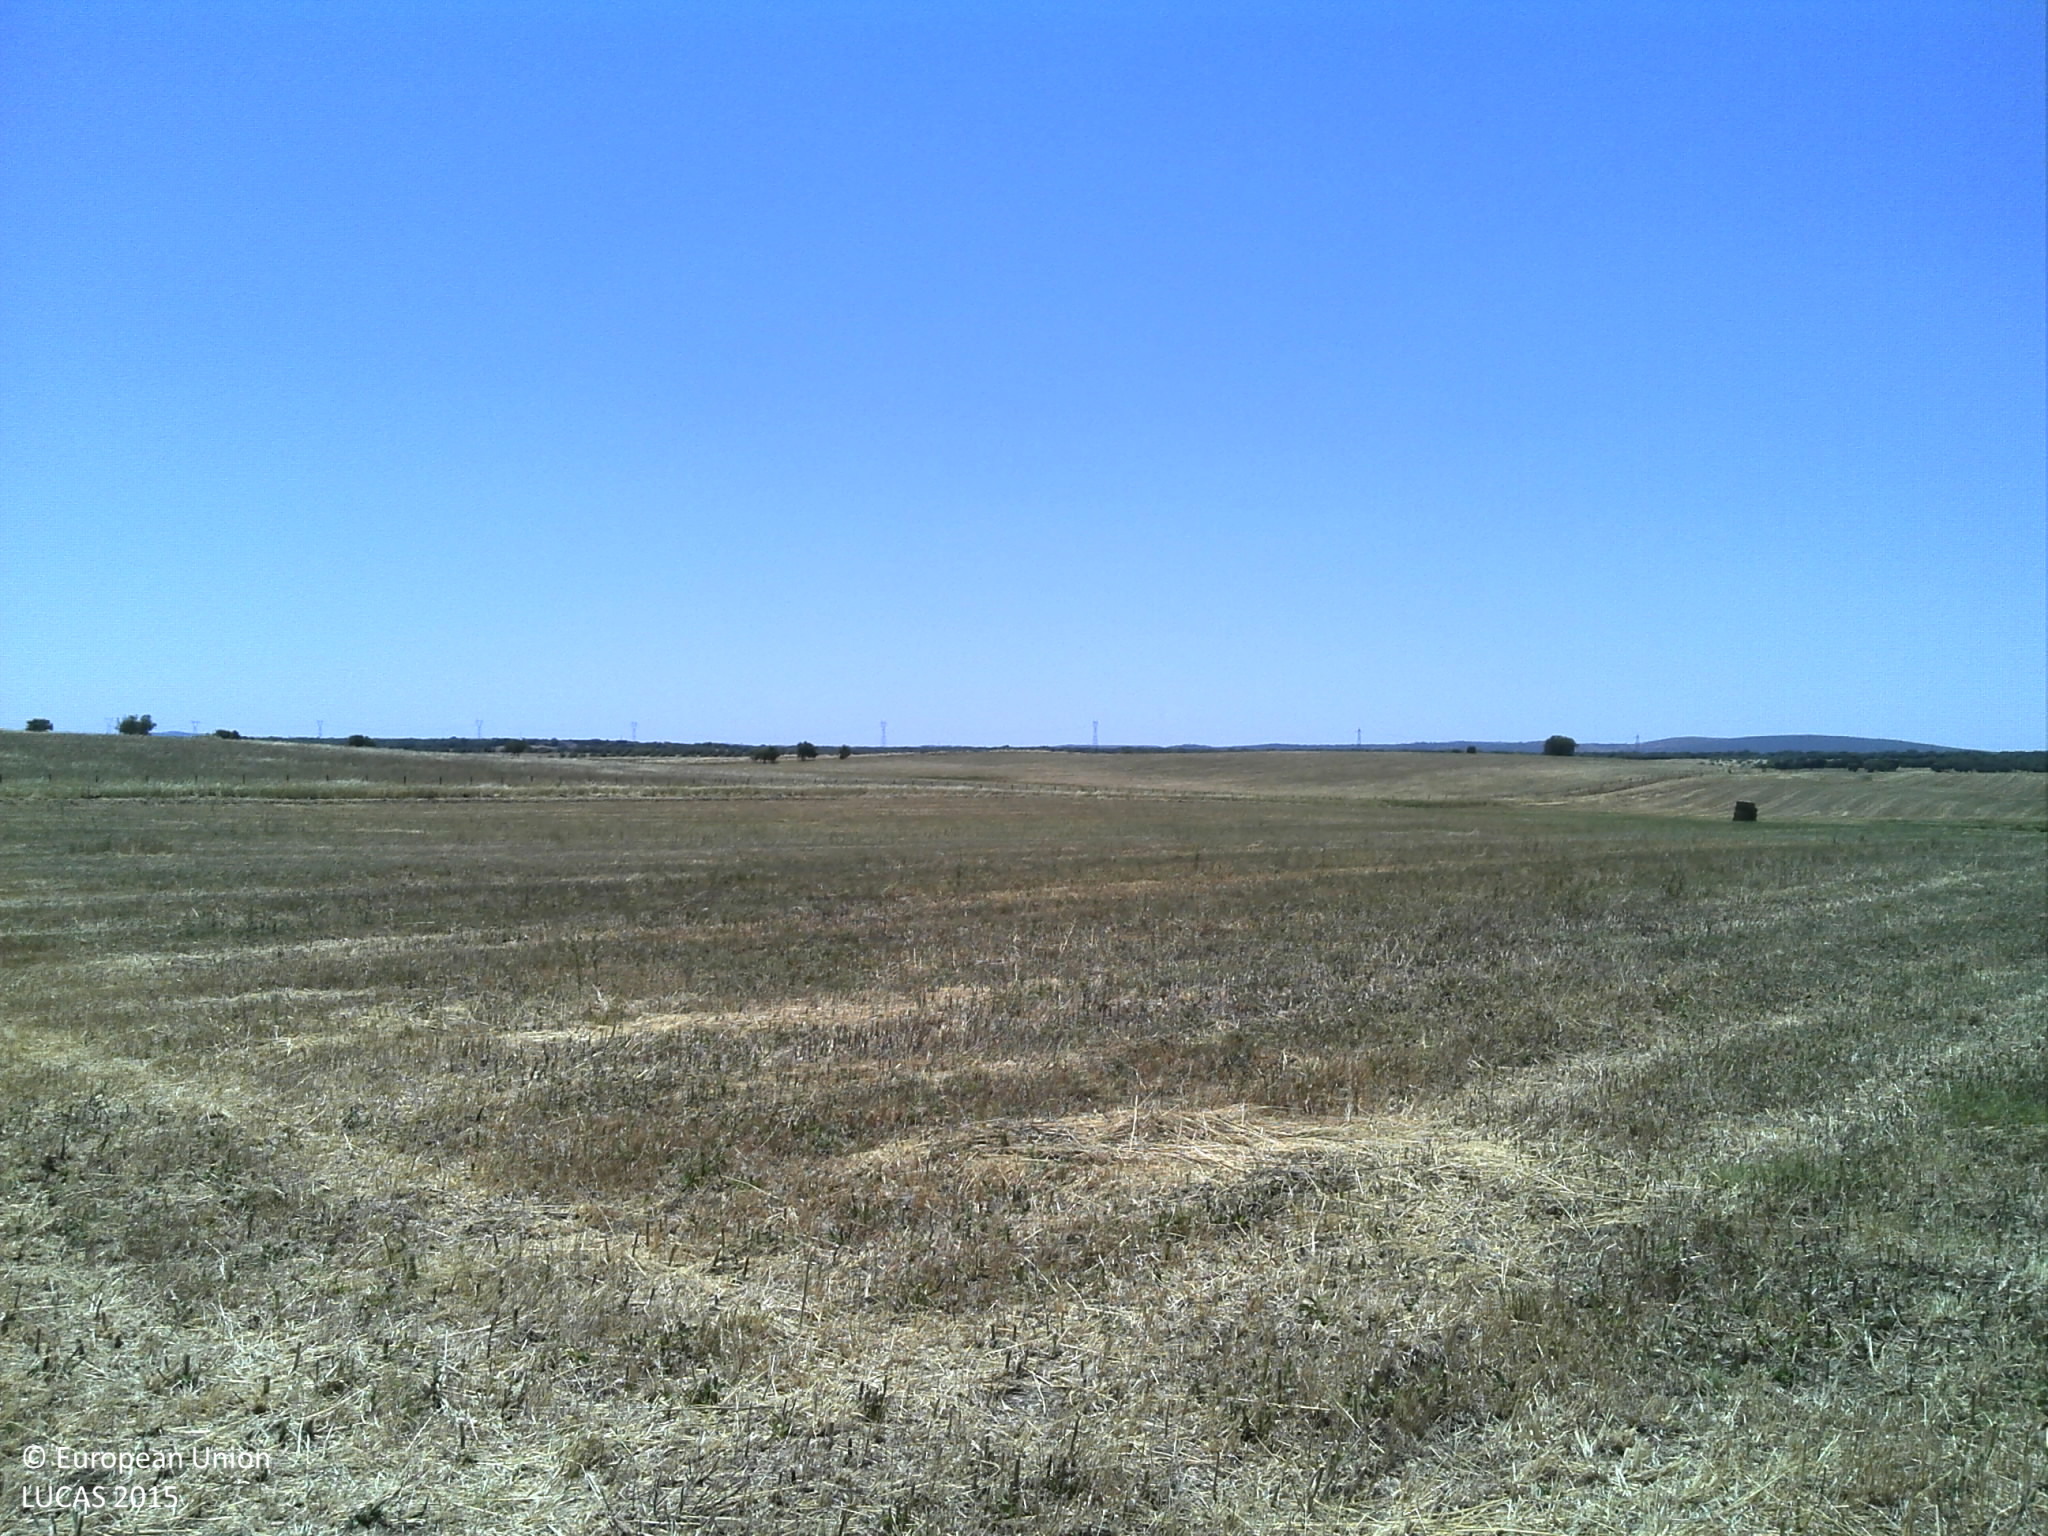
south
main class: Cropland
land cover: Oats
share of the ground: 10 - 25 %
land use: Agriculture (excluding fallow land and kitchen gardens)
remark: Harvested field
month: May
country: PT
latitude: 38.9943
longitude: -7.6012
